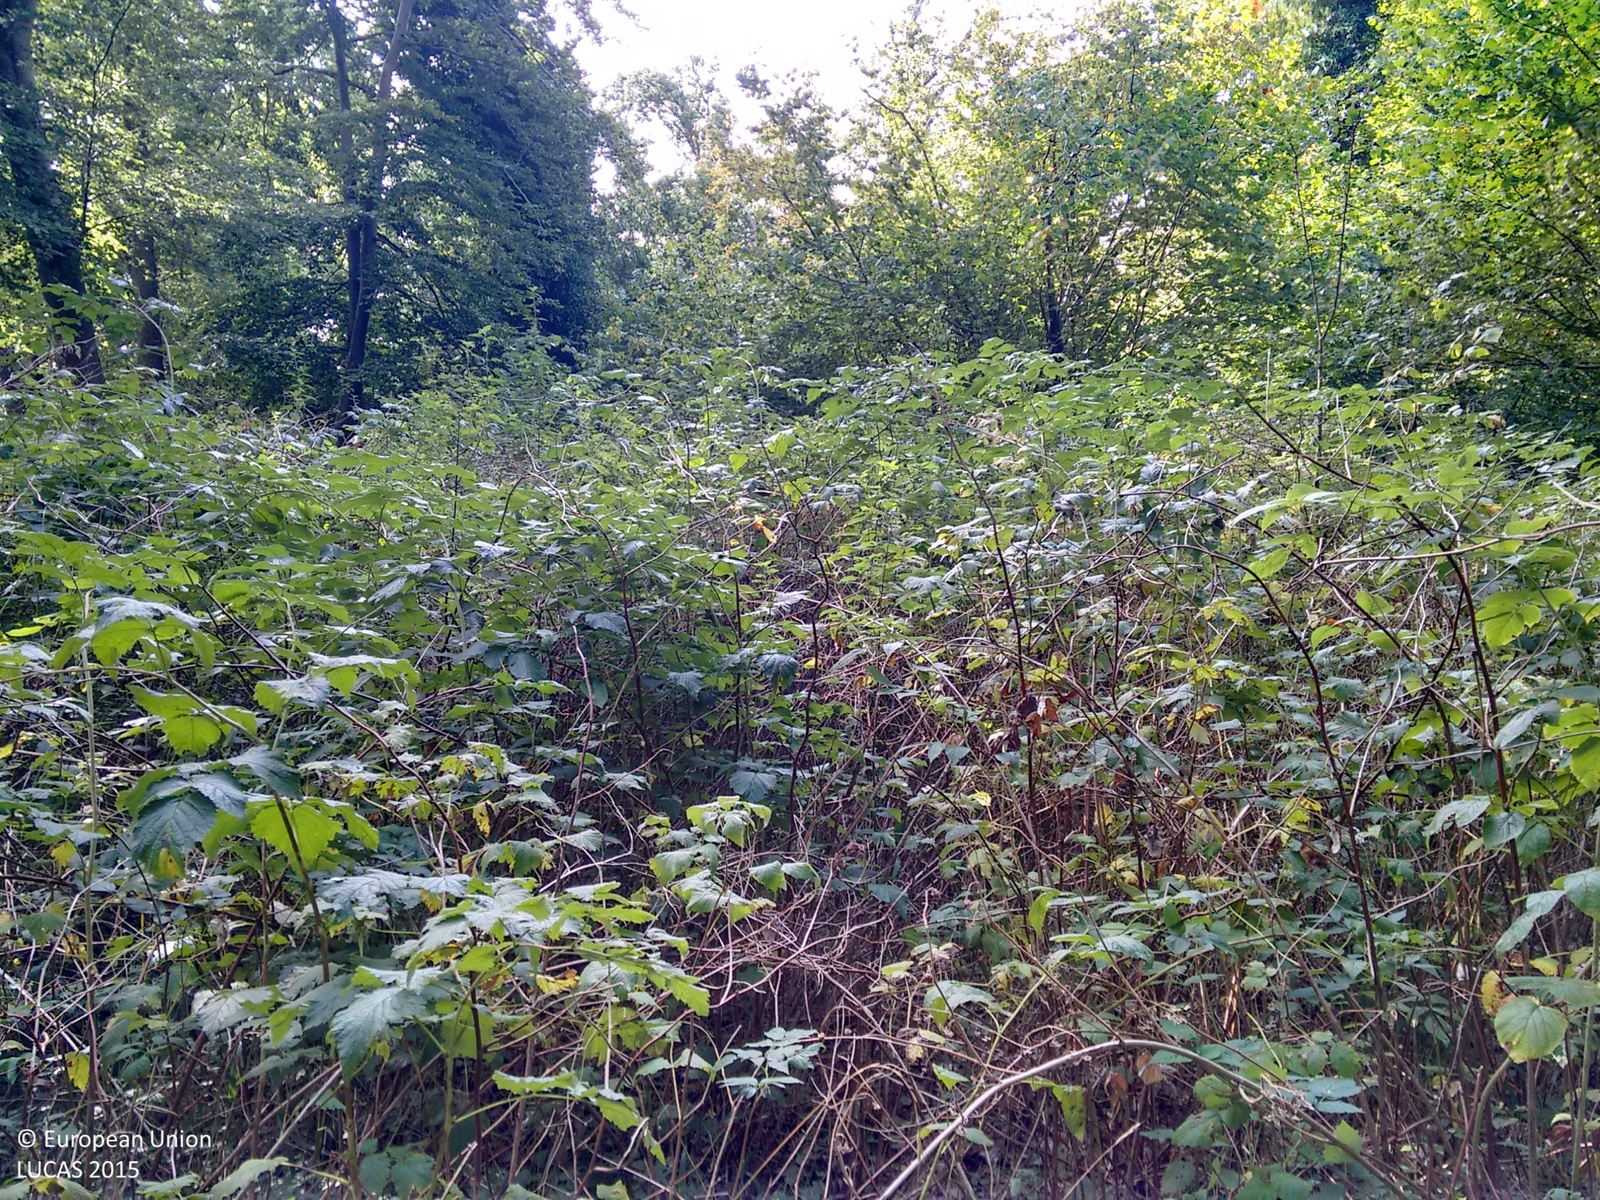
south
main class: Woodland
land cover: Broadleaved woodland
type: mesophytic deciduous forest
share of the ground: > 75 %
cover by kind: broadleaved forest trees 100 %
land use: Forestry
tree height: > 5 m
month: September
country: GB
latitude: 52.4256
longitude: 0.9025
